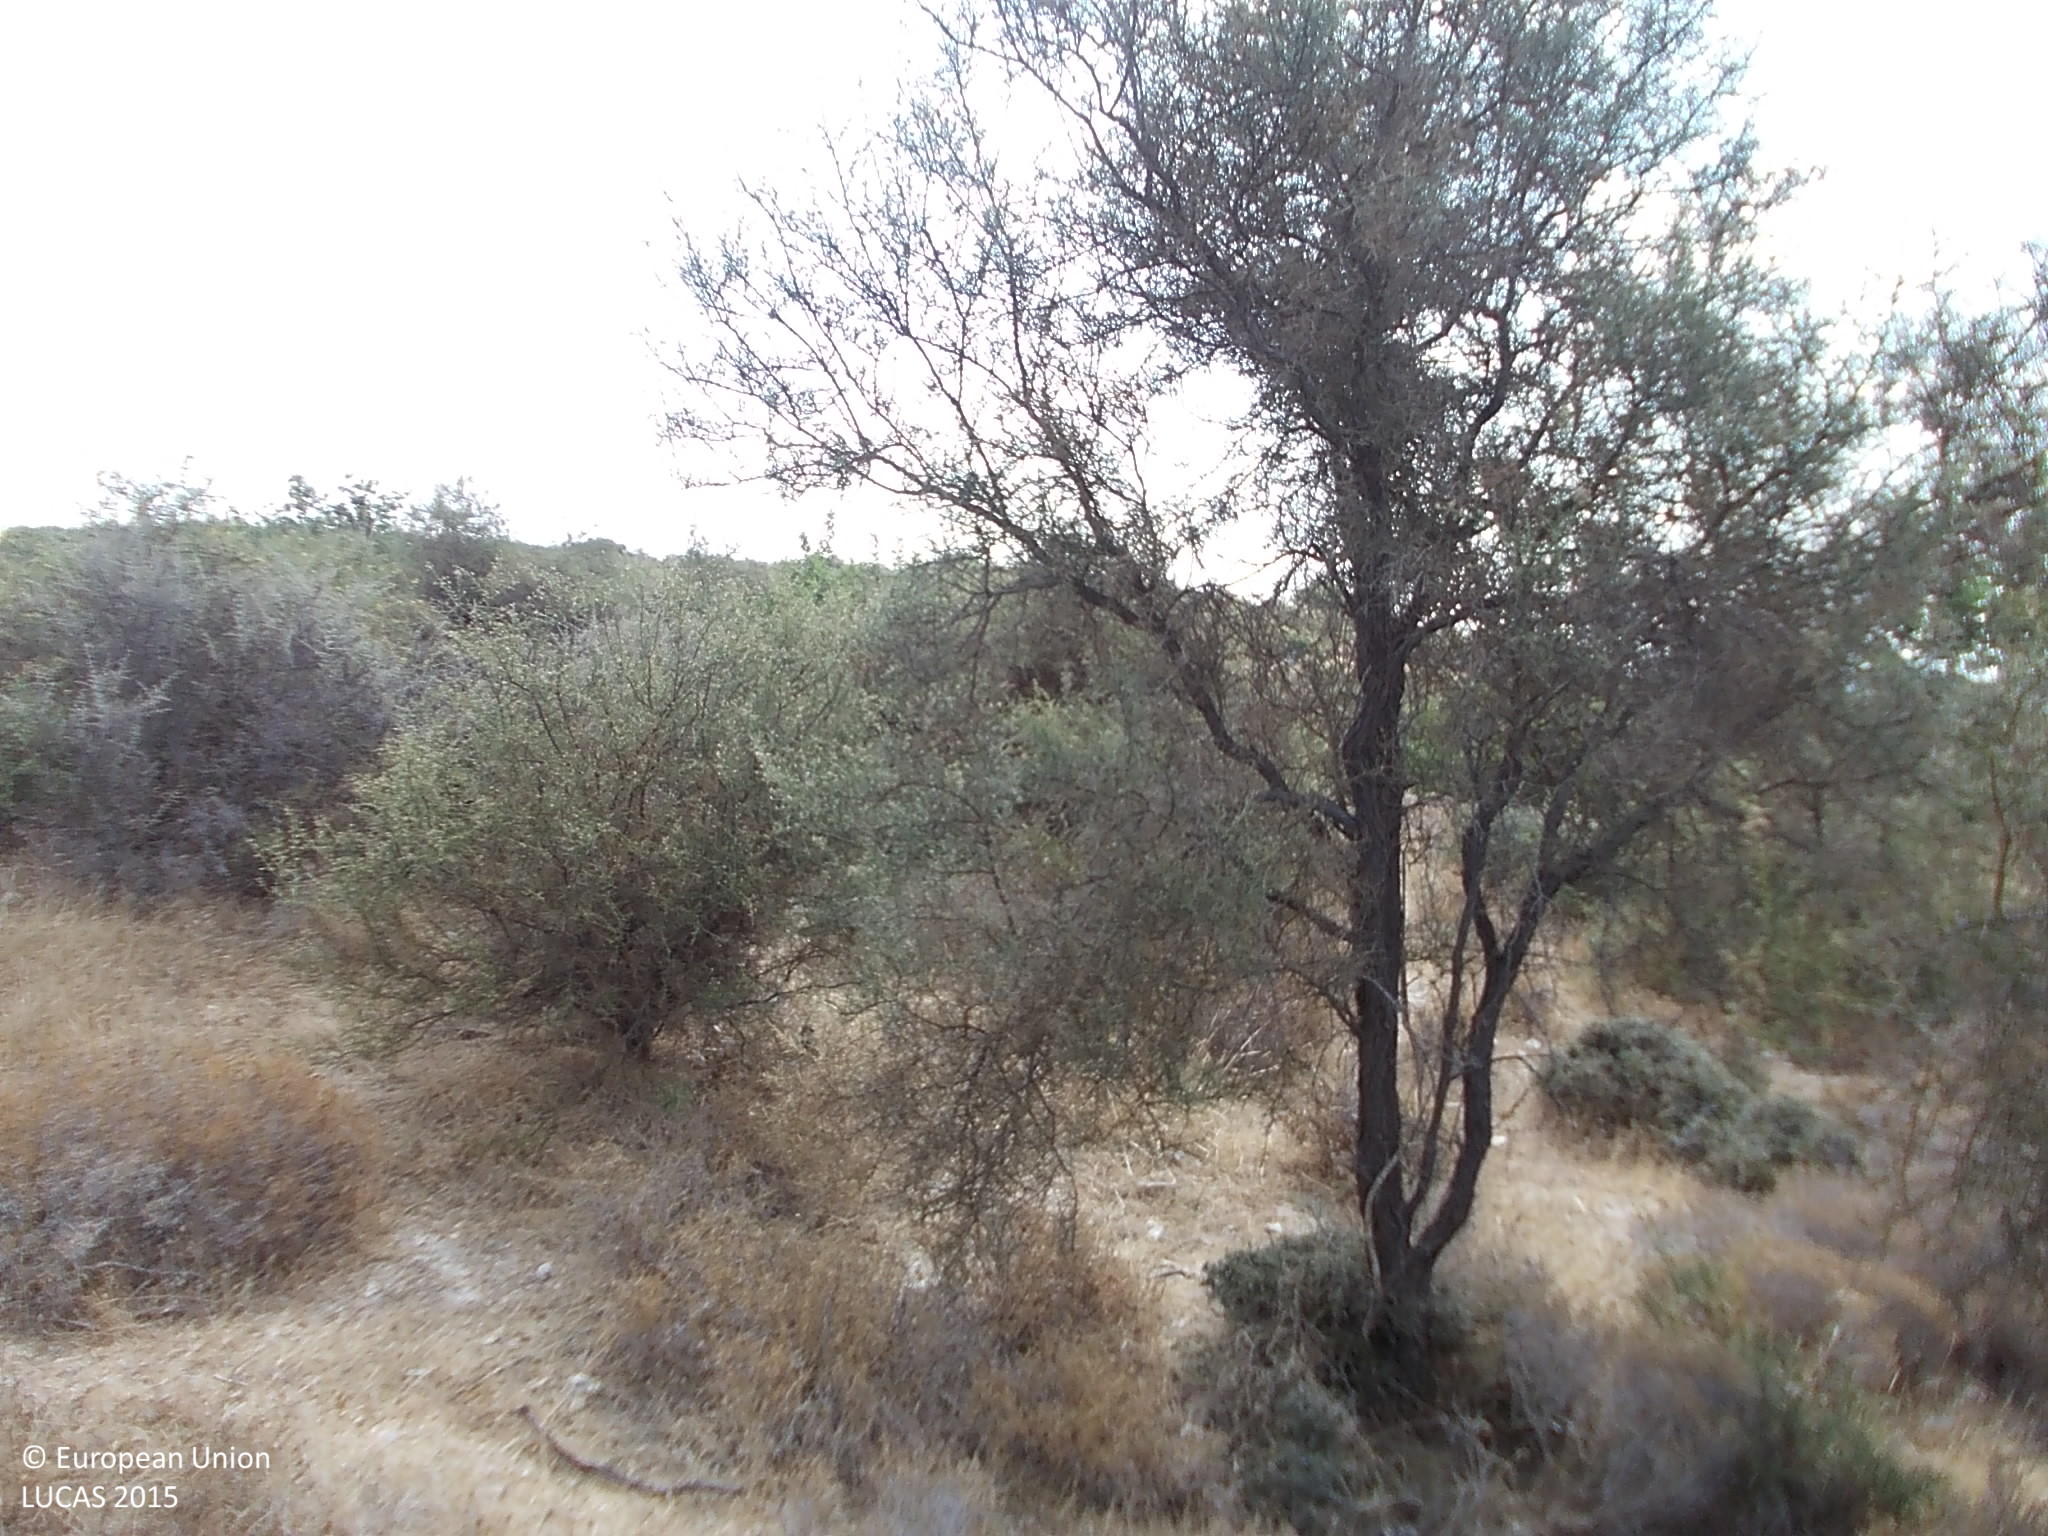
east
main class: Shrubland
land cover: Shrubland with sparse tree cover
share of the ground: > 75 %
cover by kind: shrubs 85 %, broadleaved forest trees 5 %, herbaceous plants 5 %, unconsolidated bare surface 5 %
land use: Semi-natural and natural areas not in use
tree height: < 5 m
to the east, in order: Shrubland with sparse tree cover; Shrubland without tree cover; Tracks; Shrubland without tree cover; Dry stone walls; Shrubland without tree cover; Tracks; Dry stone walls; Shrubland without tree cover; Rivers and streams; Shrubland without tree cover
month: August
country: CY
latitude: 34.7023
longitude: 32.6967
